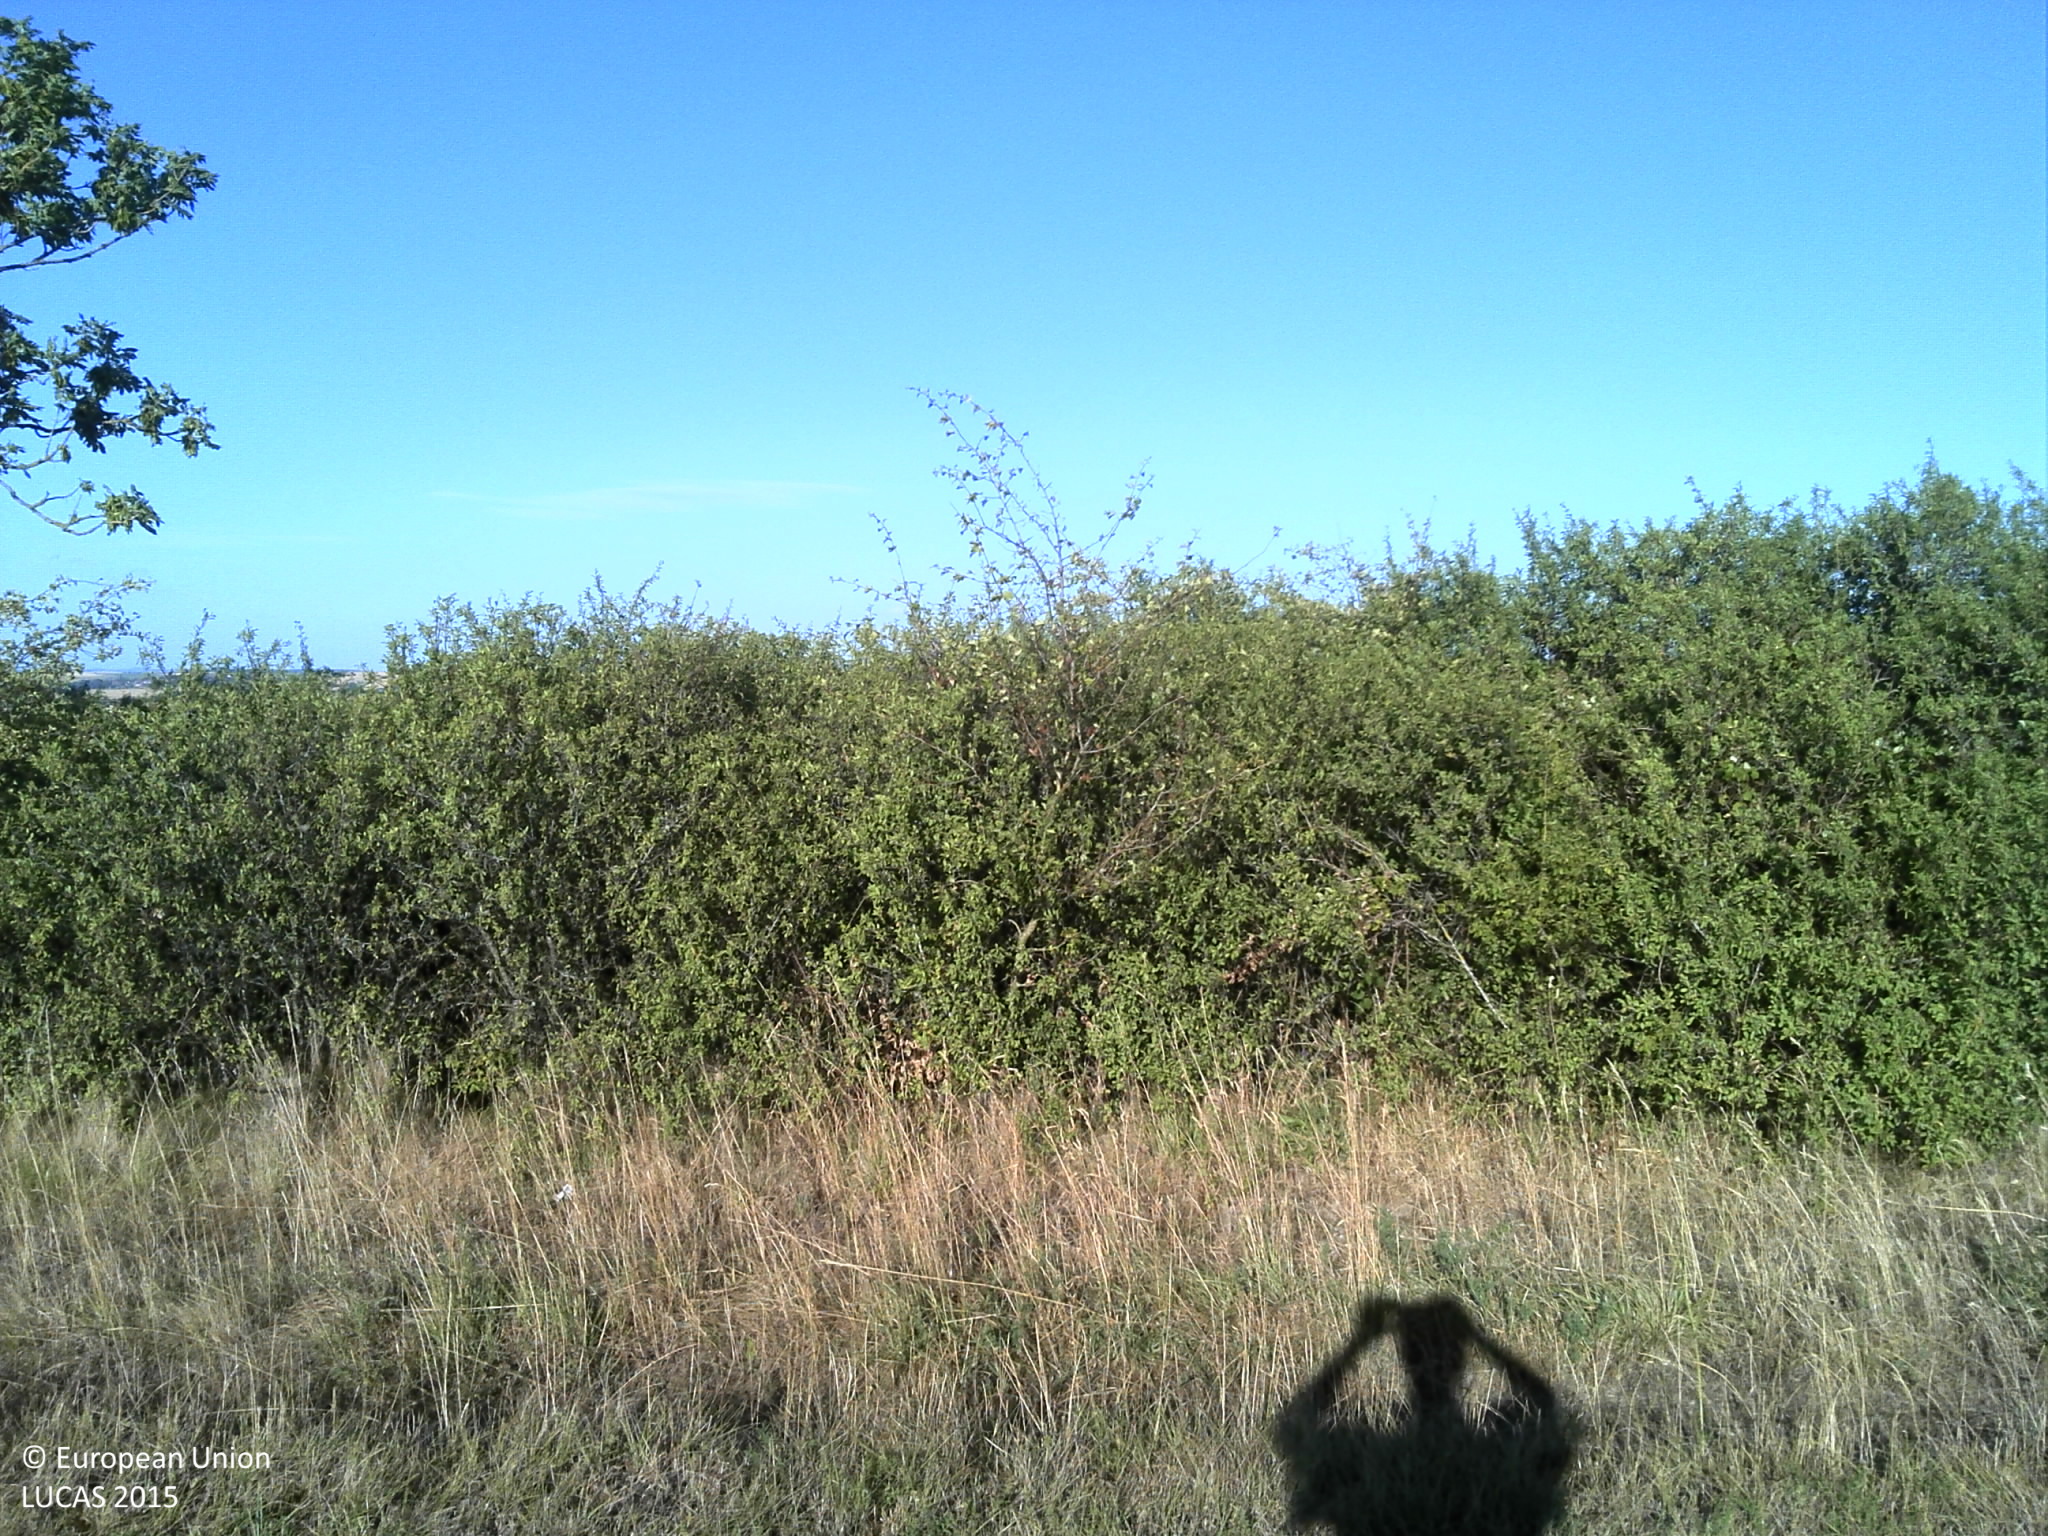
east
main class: Grassland
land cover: Grassland without tree/shrub cover
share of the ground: > 75 %
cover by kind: herbaceous plants 100 %
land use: Agriculture (excluding fallow land and kitchen gardens)
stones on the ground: < 10 %
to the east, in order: Grassland without tree/shrub cover; Tracks; Grass margins; Shrubland with sparse tree cover; Grassland without tree/shrub cover; Other fruit trees and berries; Grassland without tree/shrub cover; Inland marshes; Grassland without tree/shrub cover
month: July
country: FR
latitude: 49.1086
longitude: 7.3018
